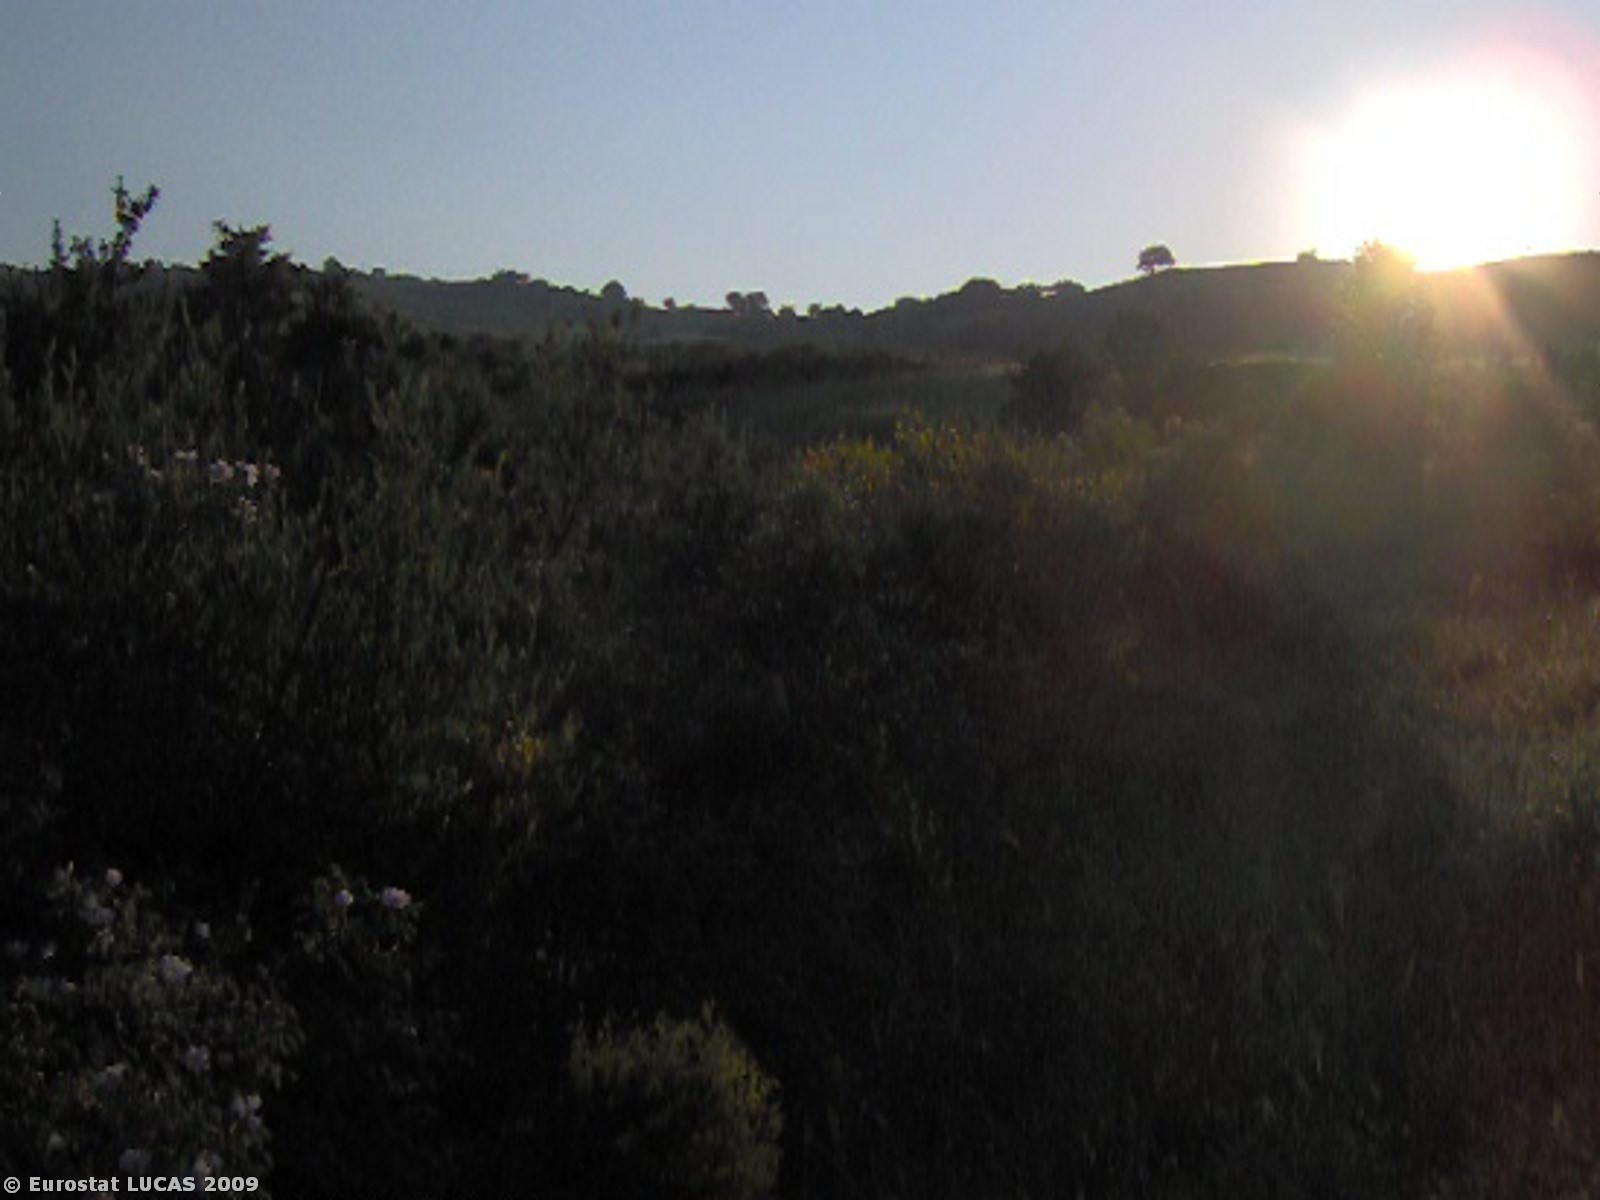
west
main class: Cropland
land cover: Mixed cereals for fodder
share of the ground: > 75 %
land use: Agriculture (excluding fallow land and kitchen gardens)
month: May
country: IT
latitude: 40.8126
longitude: 15.6336
